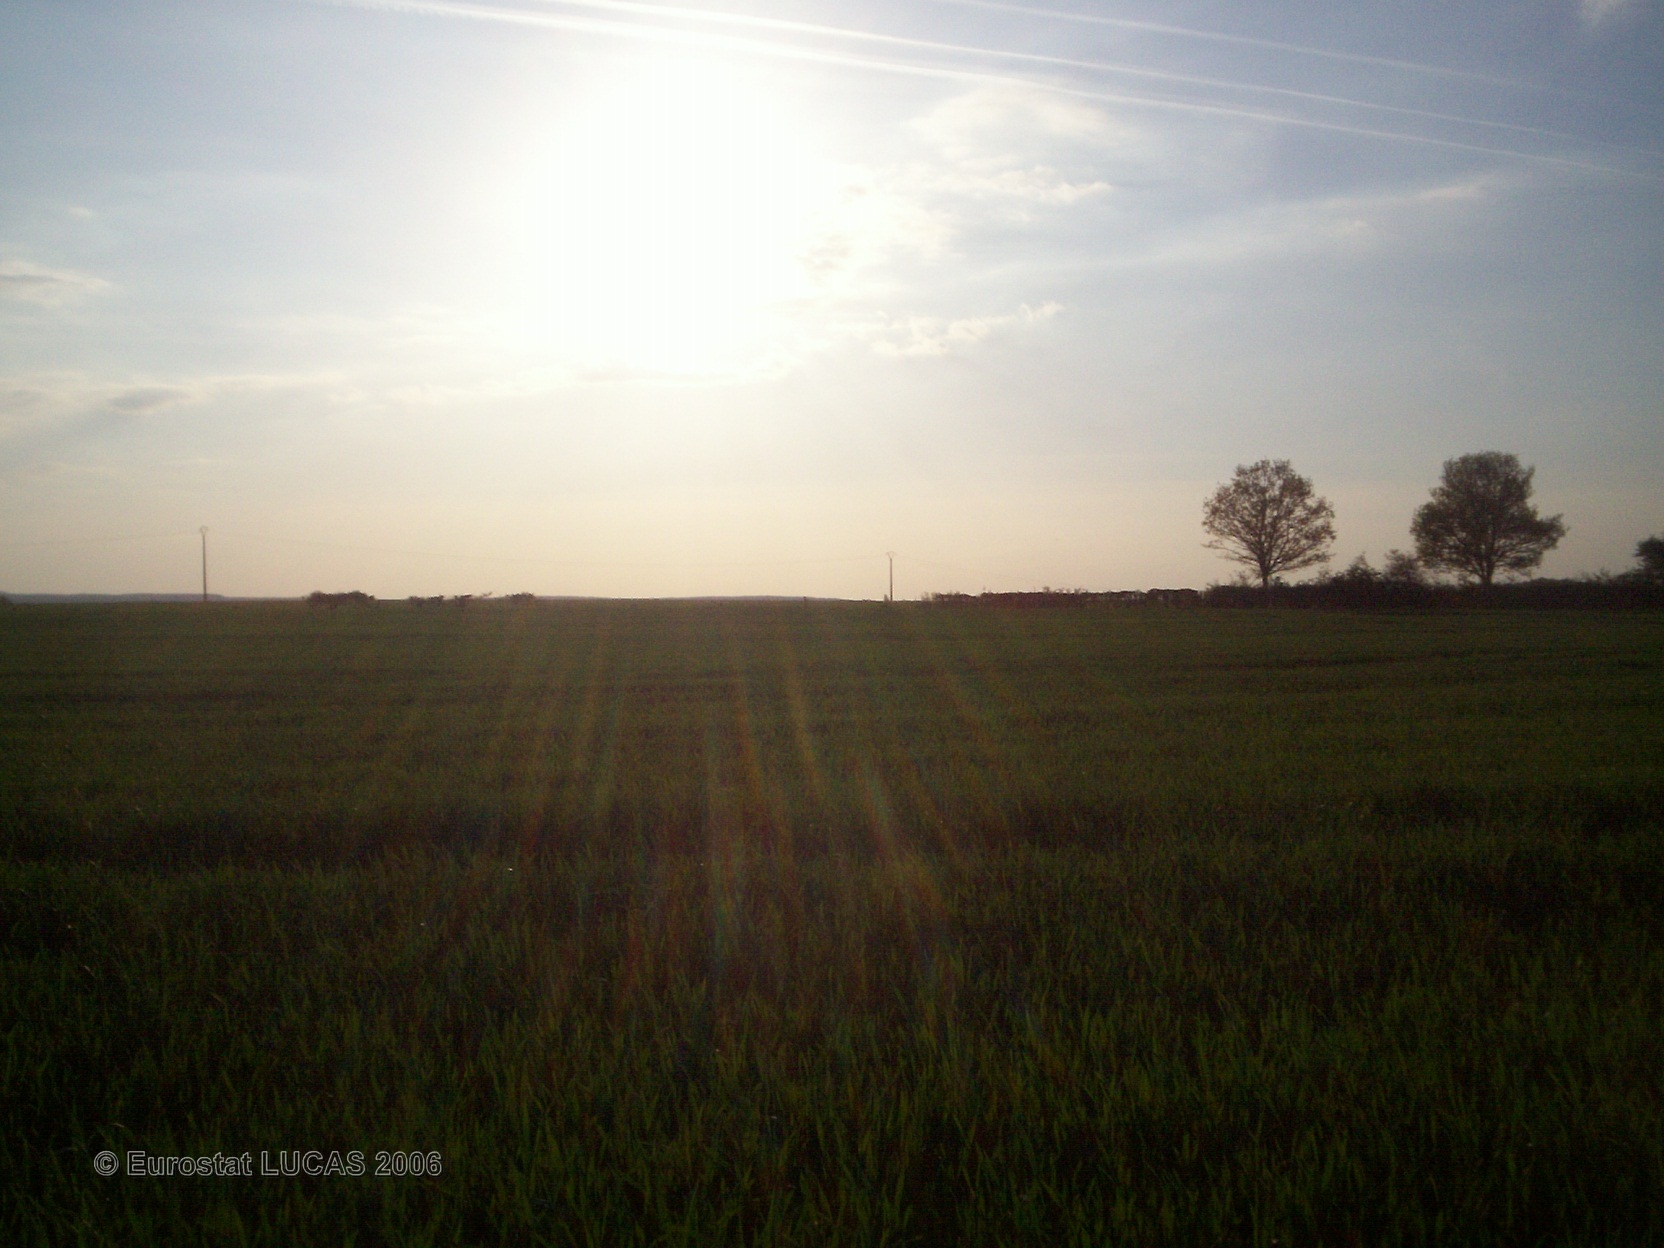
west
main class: Cropland
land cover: Barley
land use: Agriculture (excluding fallow land and kitchen gardens)
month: May
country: FR
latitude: 46.2213
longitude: 3.1404
